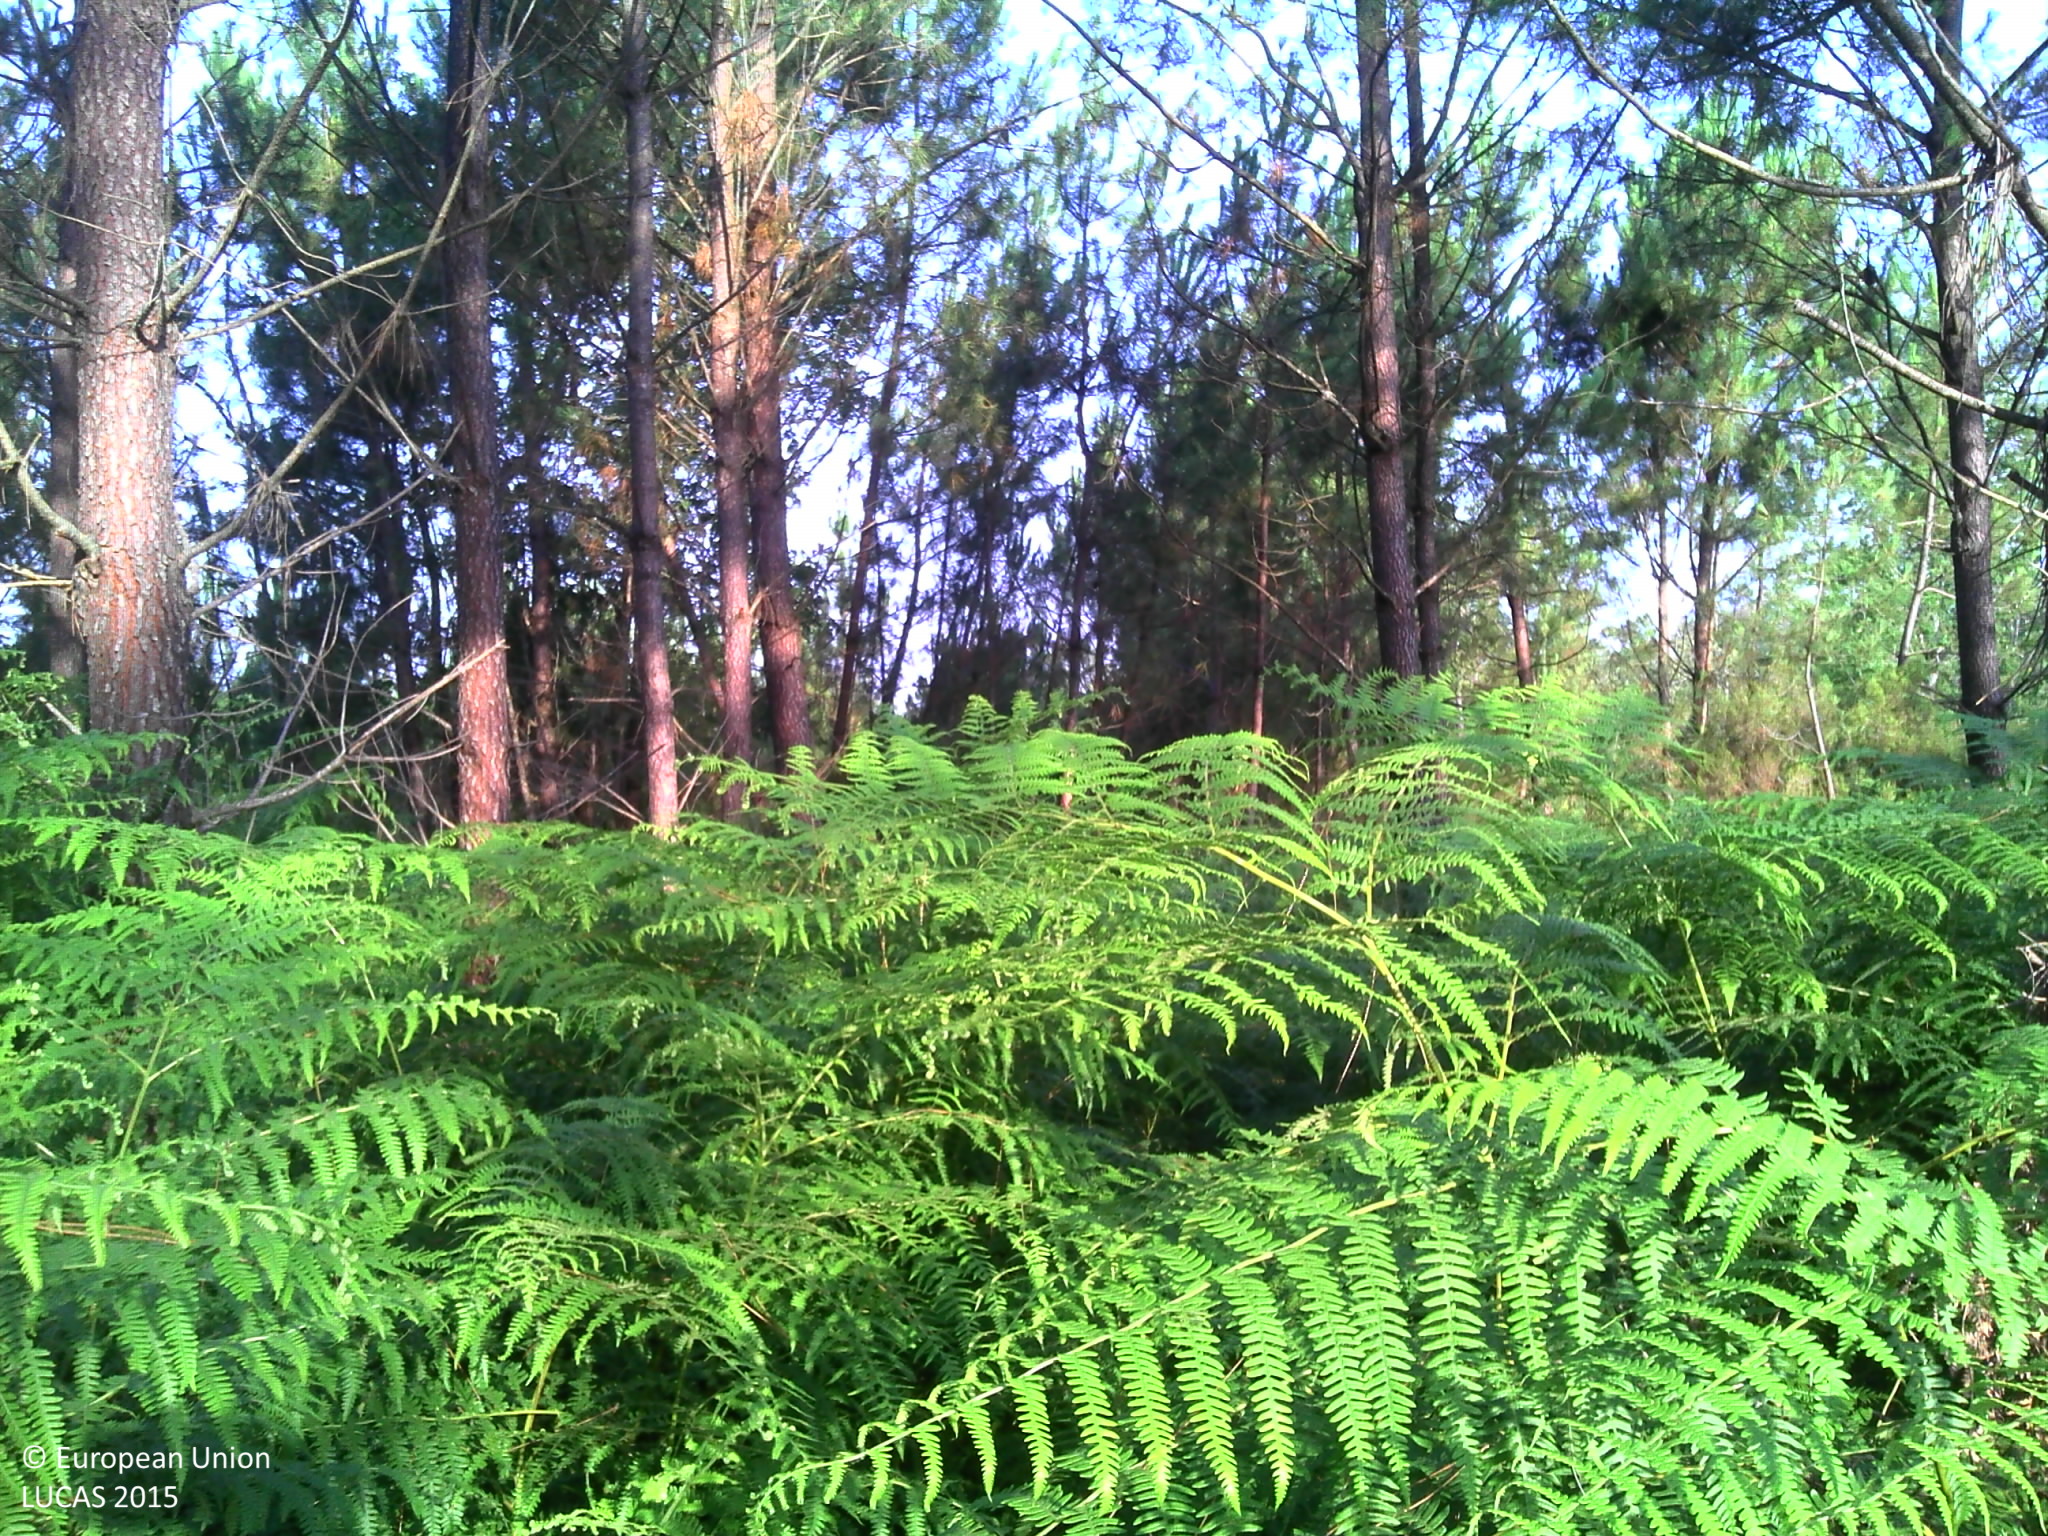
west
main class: Woodland
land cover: Pine dominated coniferous woodland
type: coniferous forest of the mediterranean region
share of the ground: > 75 %
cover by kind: coniferous forest trees 60 %, herbaceous plants 40 %
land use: Forestry
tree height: > 5 m
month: July
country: FR
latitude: 44.1179
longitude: -0.5728
